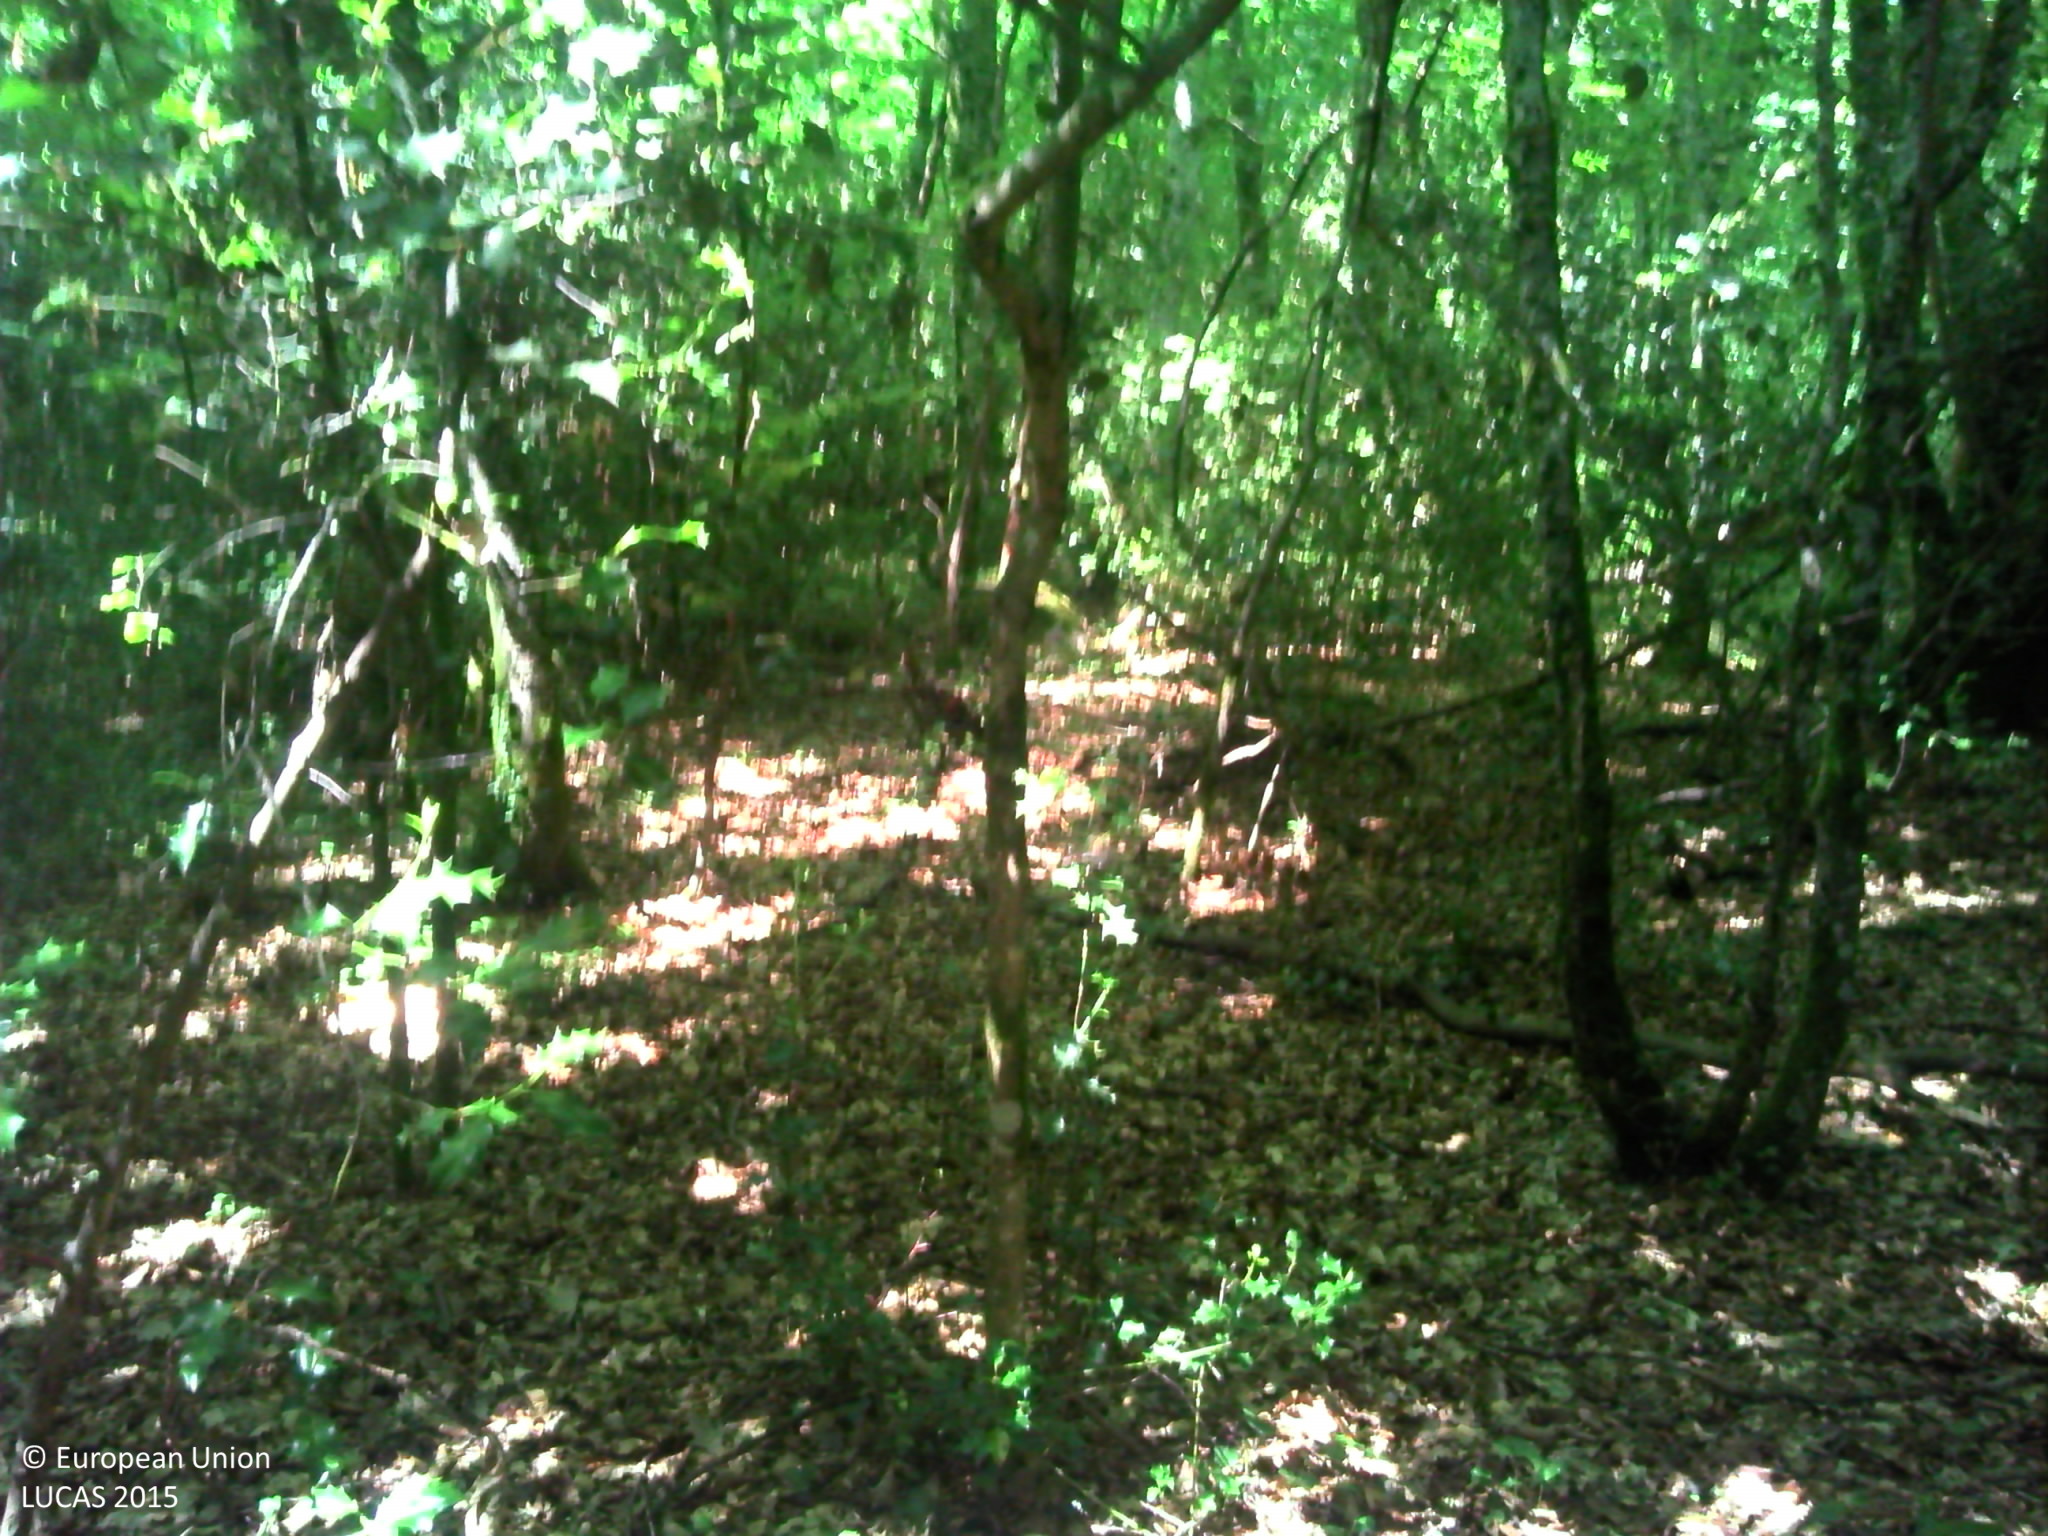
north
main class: Woodland
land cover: Broadleaved woodland
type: beech forest
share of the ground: > 75 %
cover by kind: broadleaved forest trees 100 %
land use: Forestry
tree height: > 5 m
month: July
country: FR
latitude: 46.1742
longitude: 1.7151
